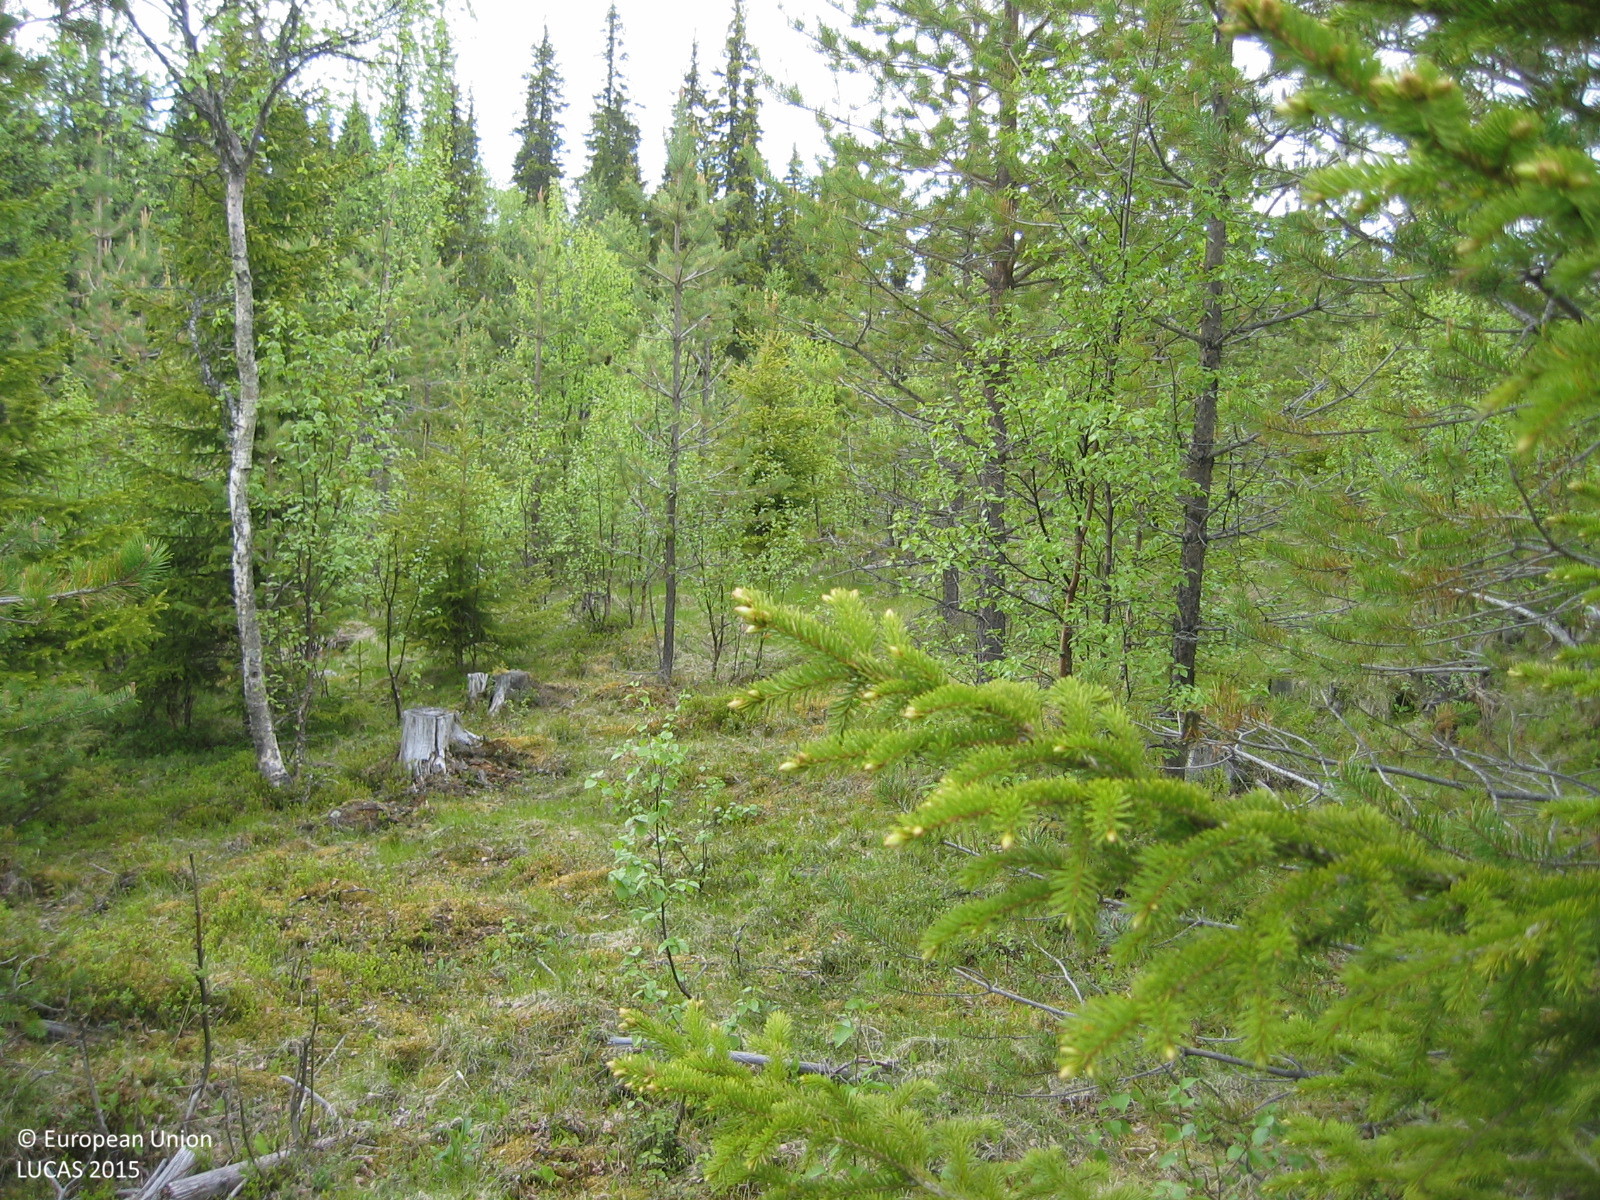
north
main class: Woodland
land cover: Other mixed woodland
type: boreal forest
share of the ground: 50 - 75 %
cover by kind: coniferous forest trees 50 %, broadleaved forest trees 25 %, herbaceous plants 25 %
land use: Forestry
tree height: < 5 m
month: June
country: SE
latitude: 63.5351
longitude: 14.6233
